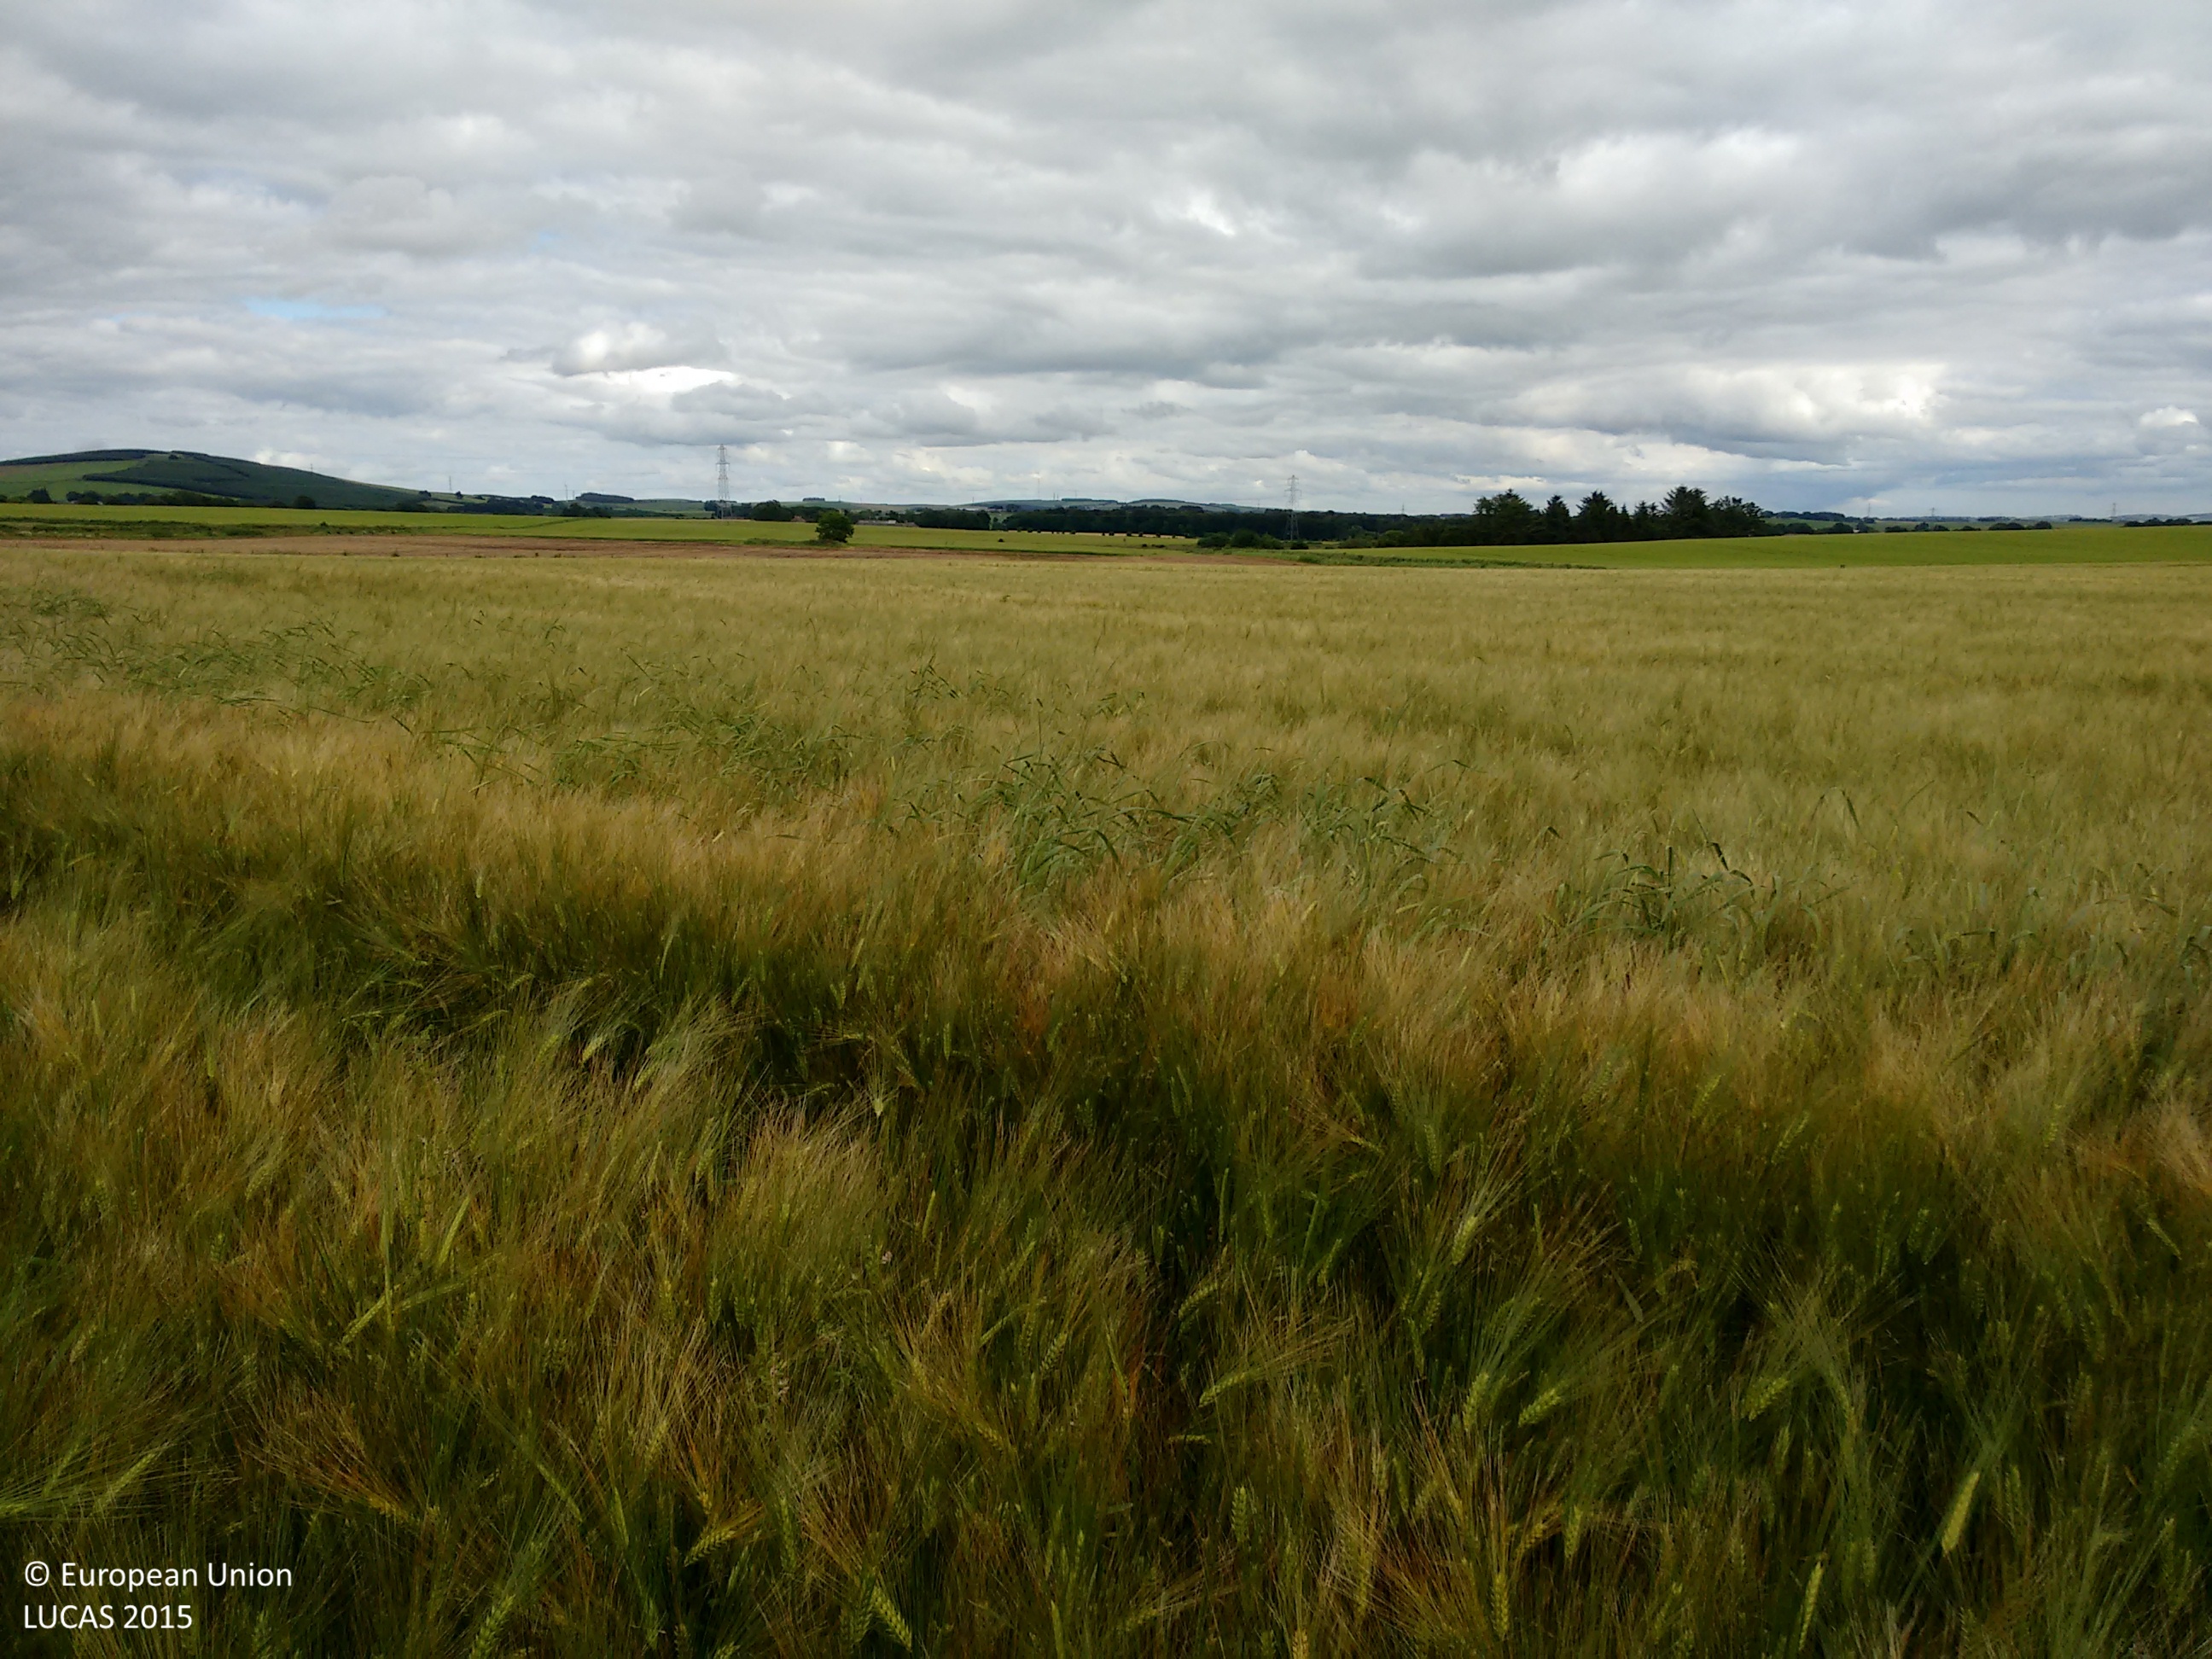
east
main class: Cropland
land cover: Barley
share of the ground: > 75 %
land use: Agriculture (excluding fallow land and kitchen gardens)
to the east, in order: Barley; Grass margins; Paved roads, cycling and walking lanes; Grass margins; Fences; Other bare soil; Grass margins; Fences
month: July
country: GB
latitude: 57.3705
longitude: -2.5758
